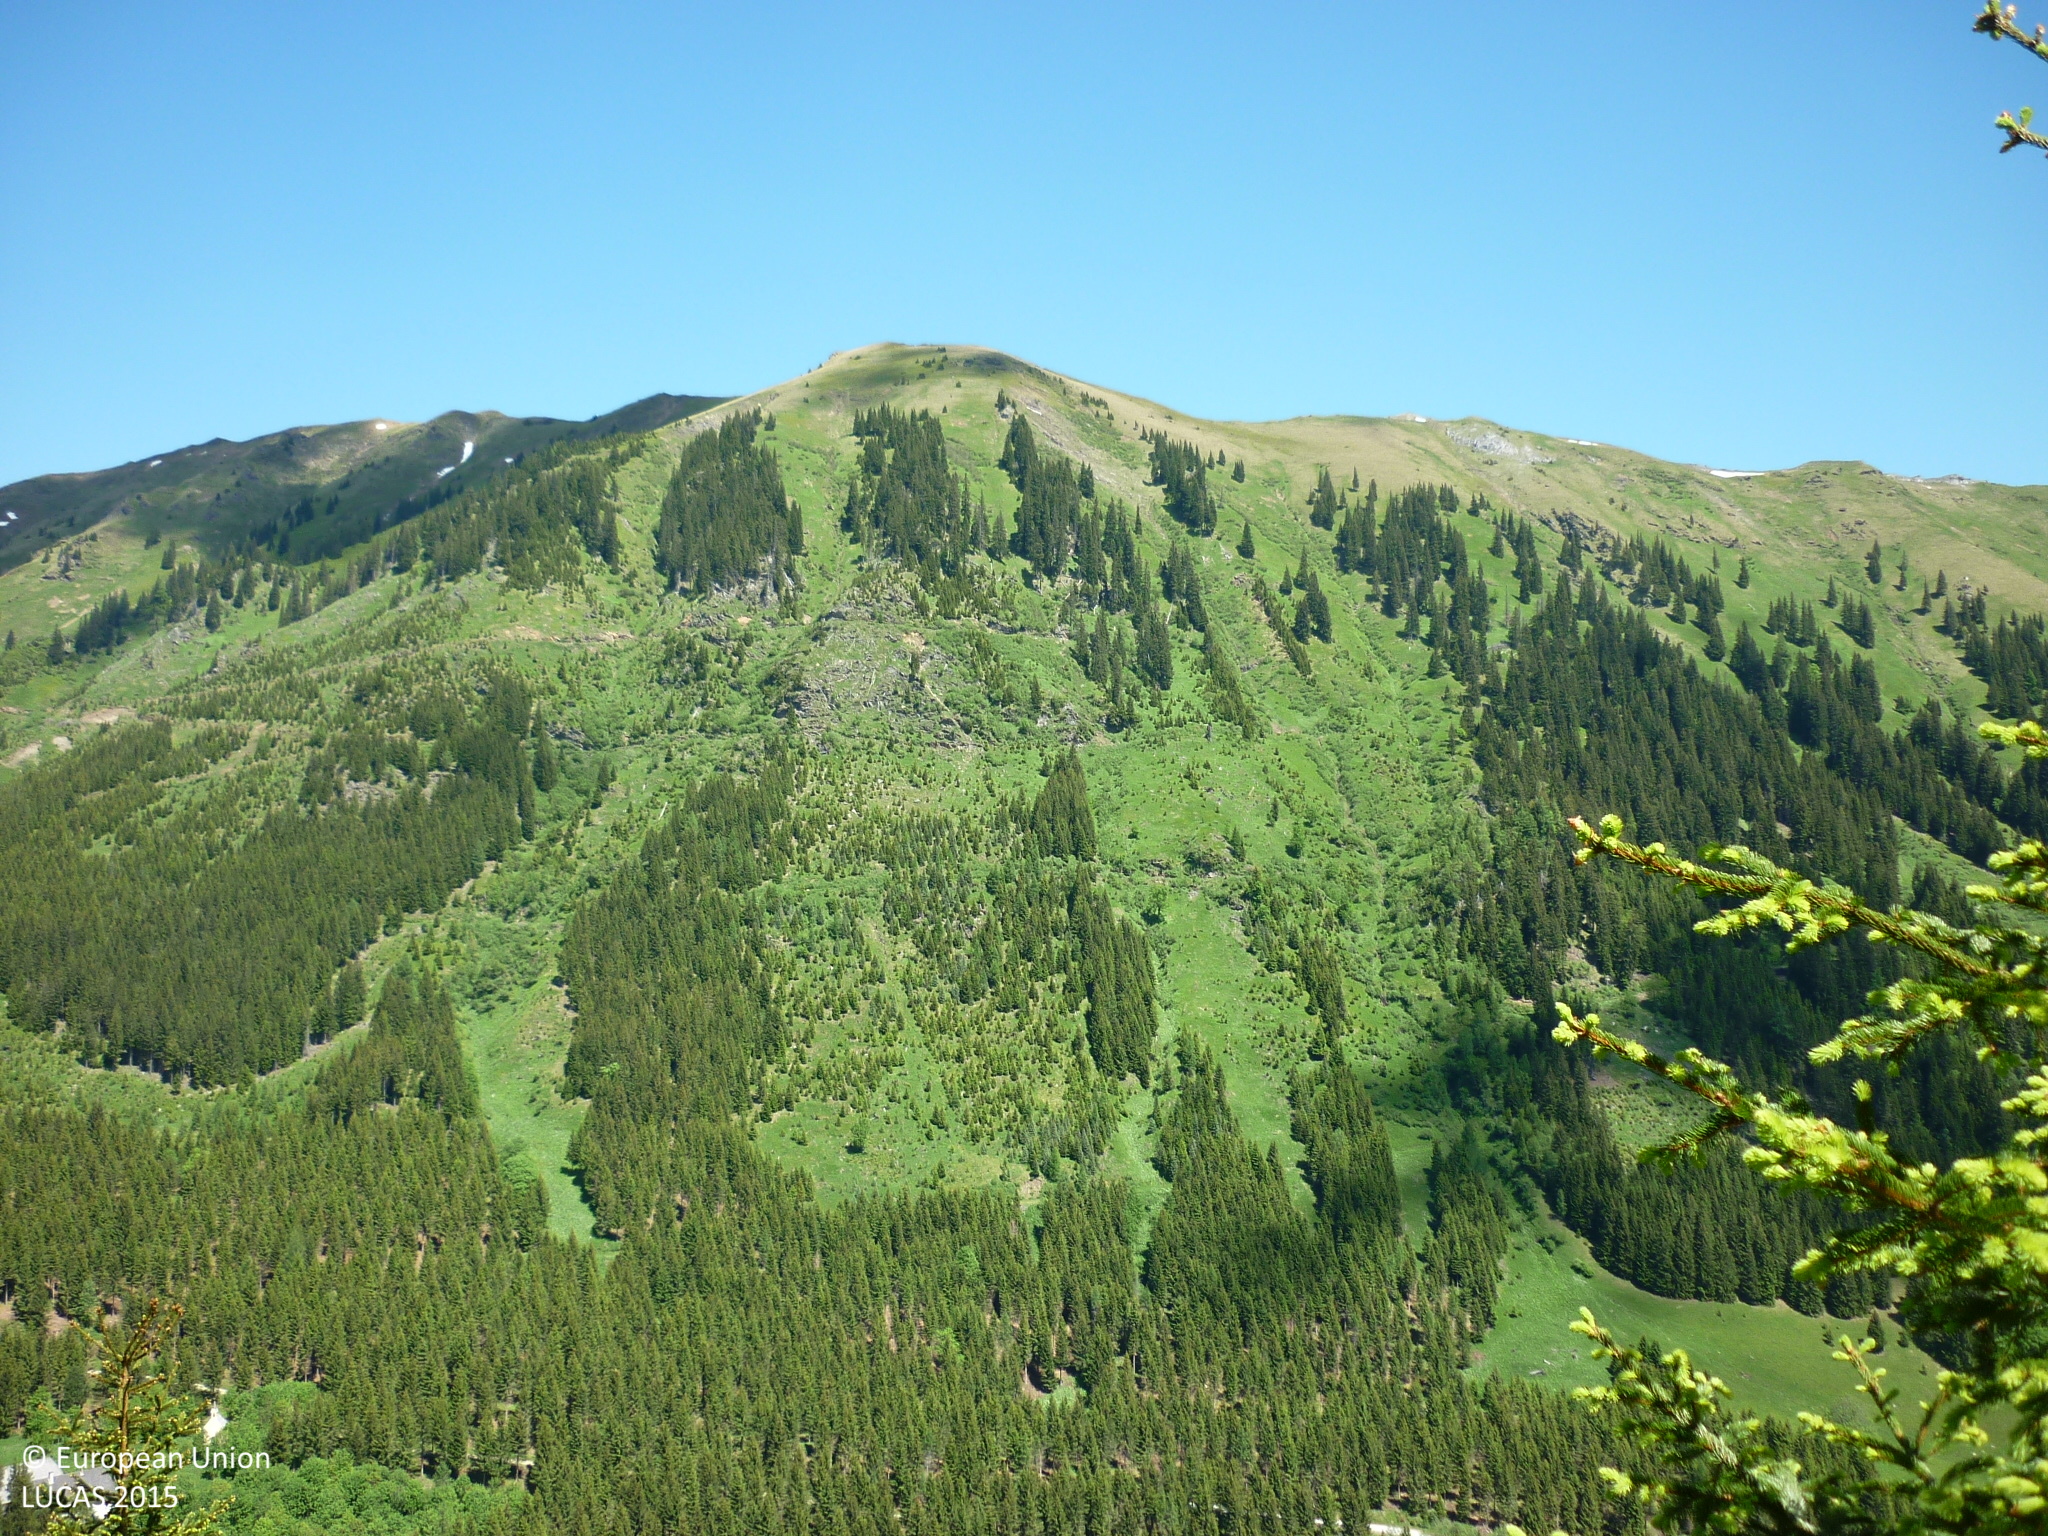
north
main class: Woodland
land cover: Spruce dominated coniferous woodland
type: alpine coniferous forest
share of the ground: 25 - 50 %
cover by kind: herbaceous plants 70 %, coniferous forest trees 25 %, shrubs 5 %
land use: Forestry
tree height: < 5 m
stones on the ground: < 10 %
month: June
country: AT
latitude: 47.3477
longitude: 14.2743
